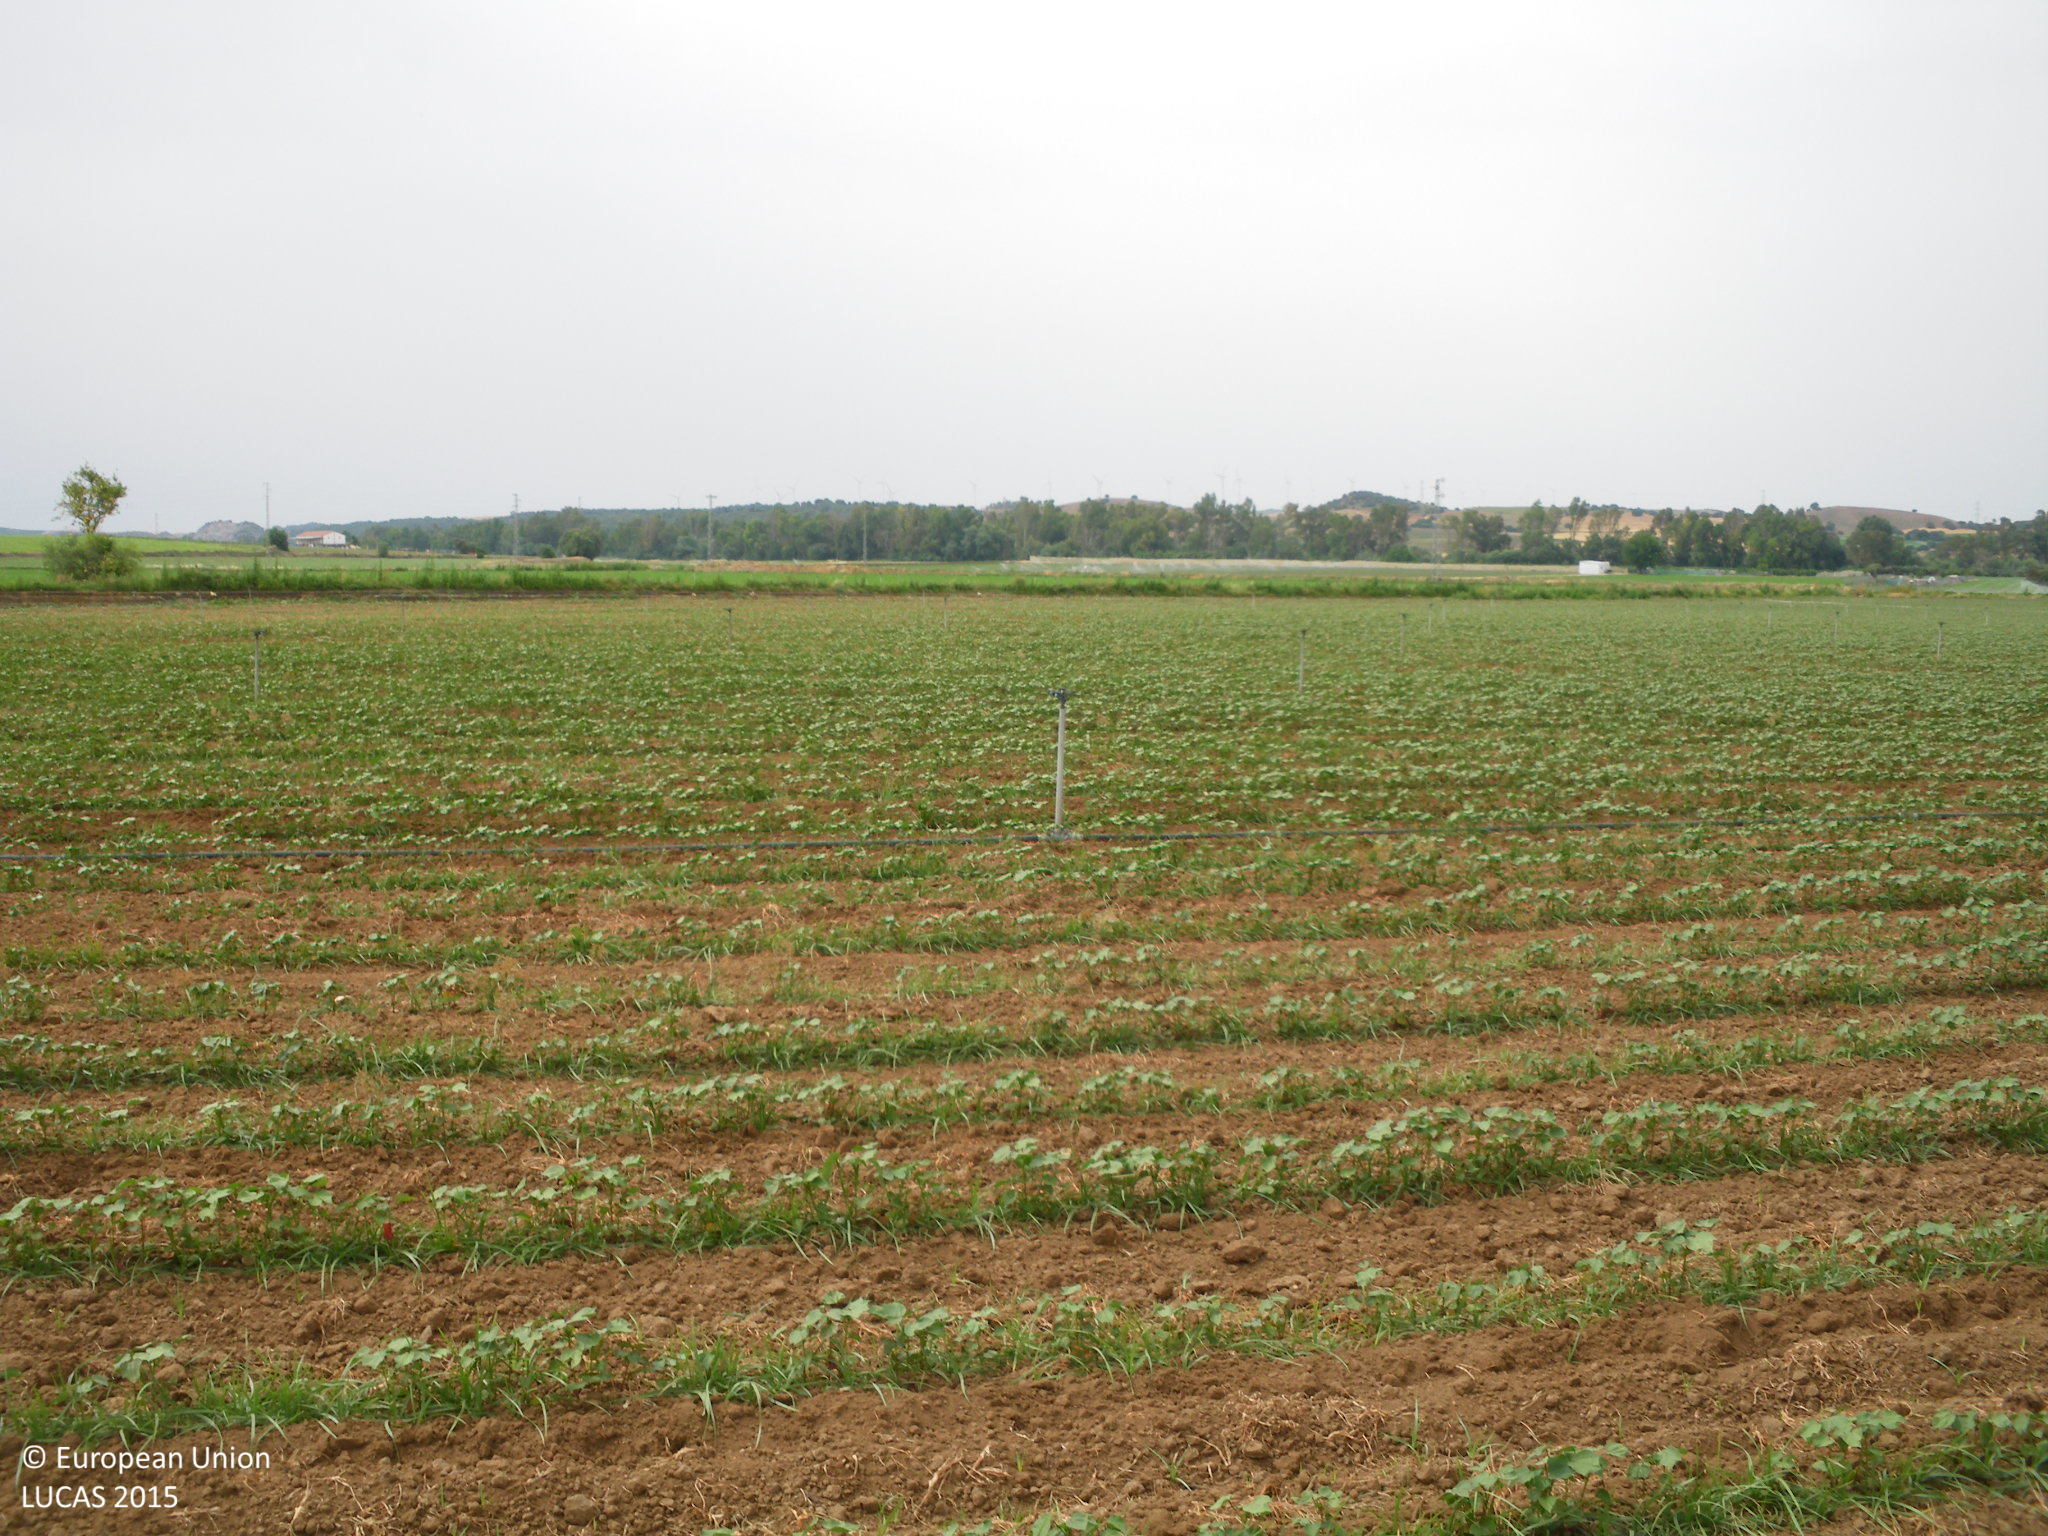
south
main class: Cropland
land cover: Cotton
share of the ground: 10 - 25 %
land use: Agriculture (excluding fallow land and kitchen gardens)
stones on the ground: < 10 %
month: June
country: ES
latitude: 36.6428
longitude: -5.9924
